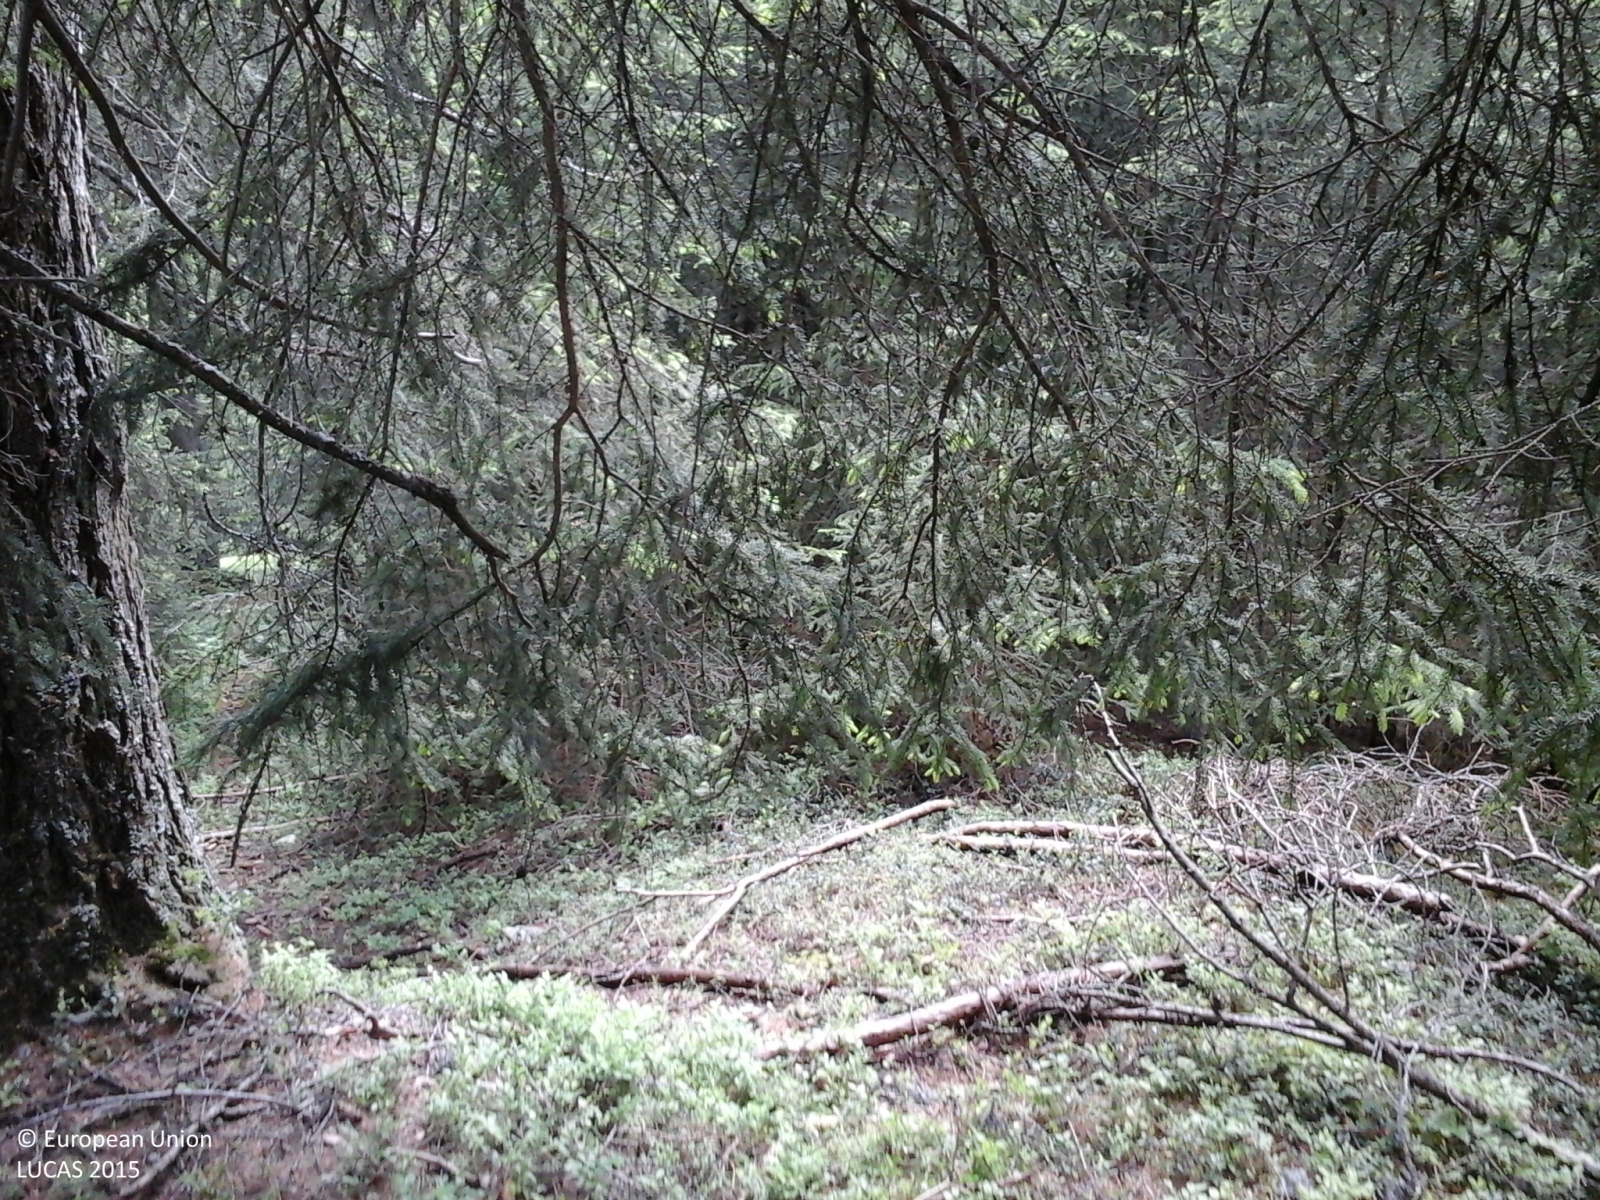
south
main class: Woodland
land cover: Spruce dominated coniferous woodland
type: alpine coniferous forest
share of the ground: > 75 %
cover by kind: coniferous forest trees 100 %
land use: Forestry
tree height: > 5 m
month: June
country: IT
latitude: 46.9699
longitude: 11.5888
